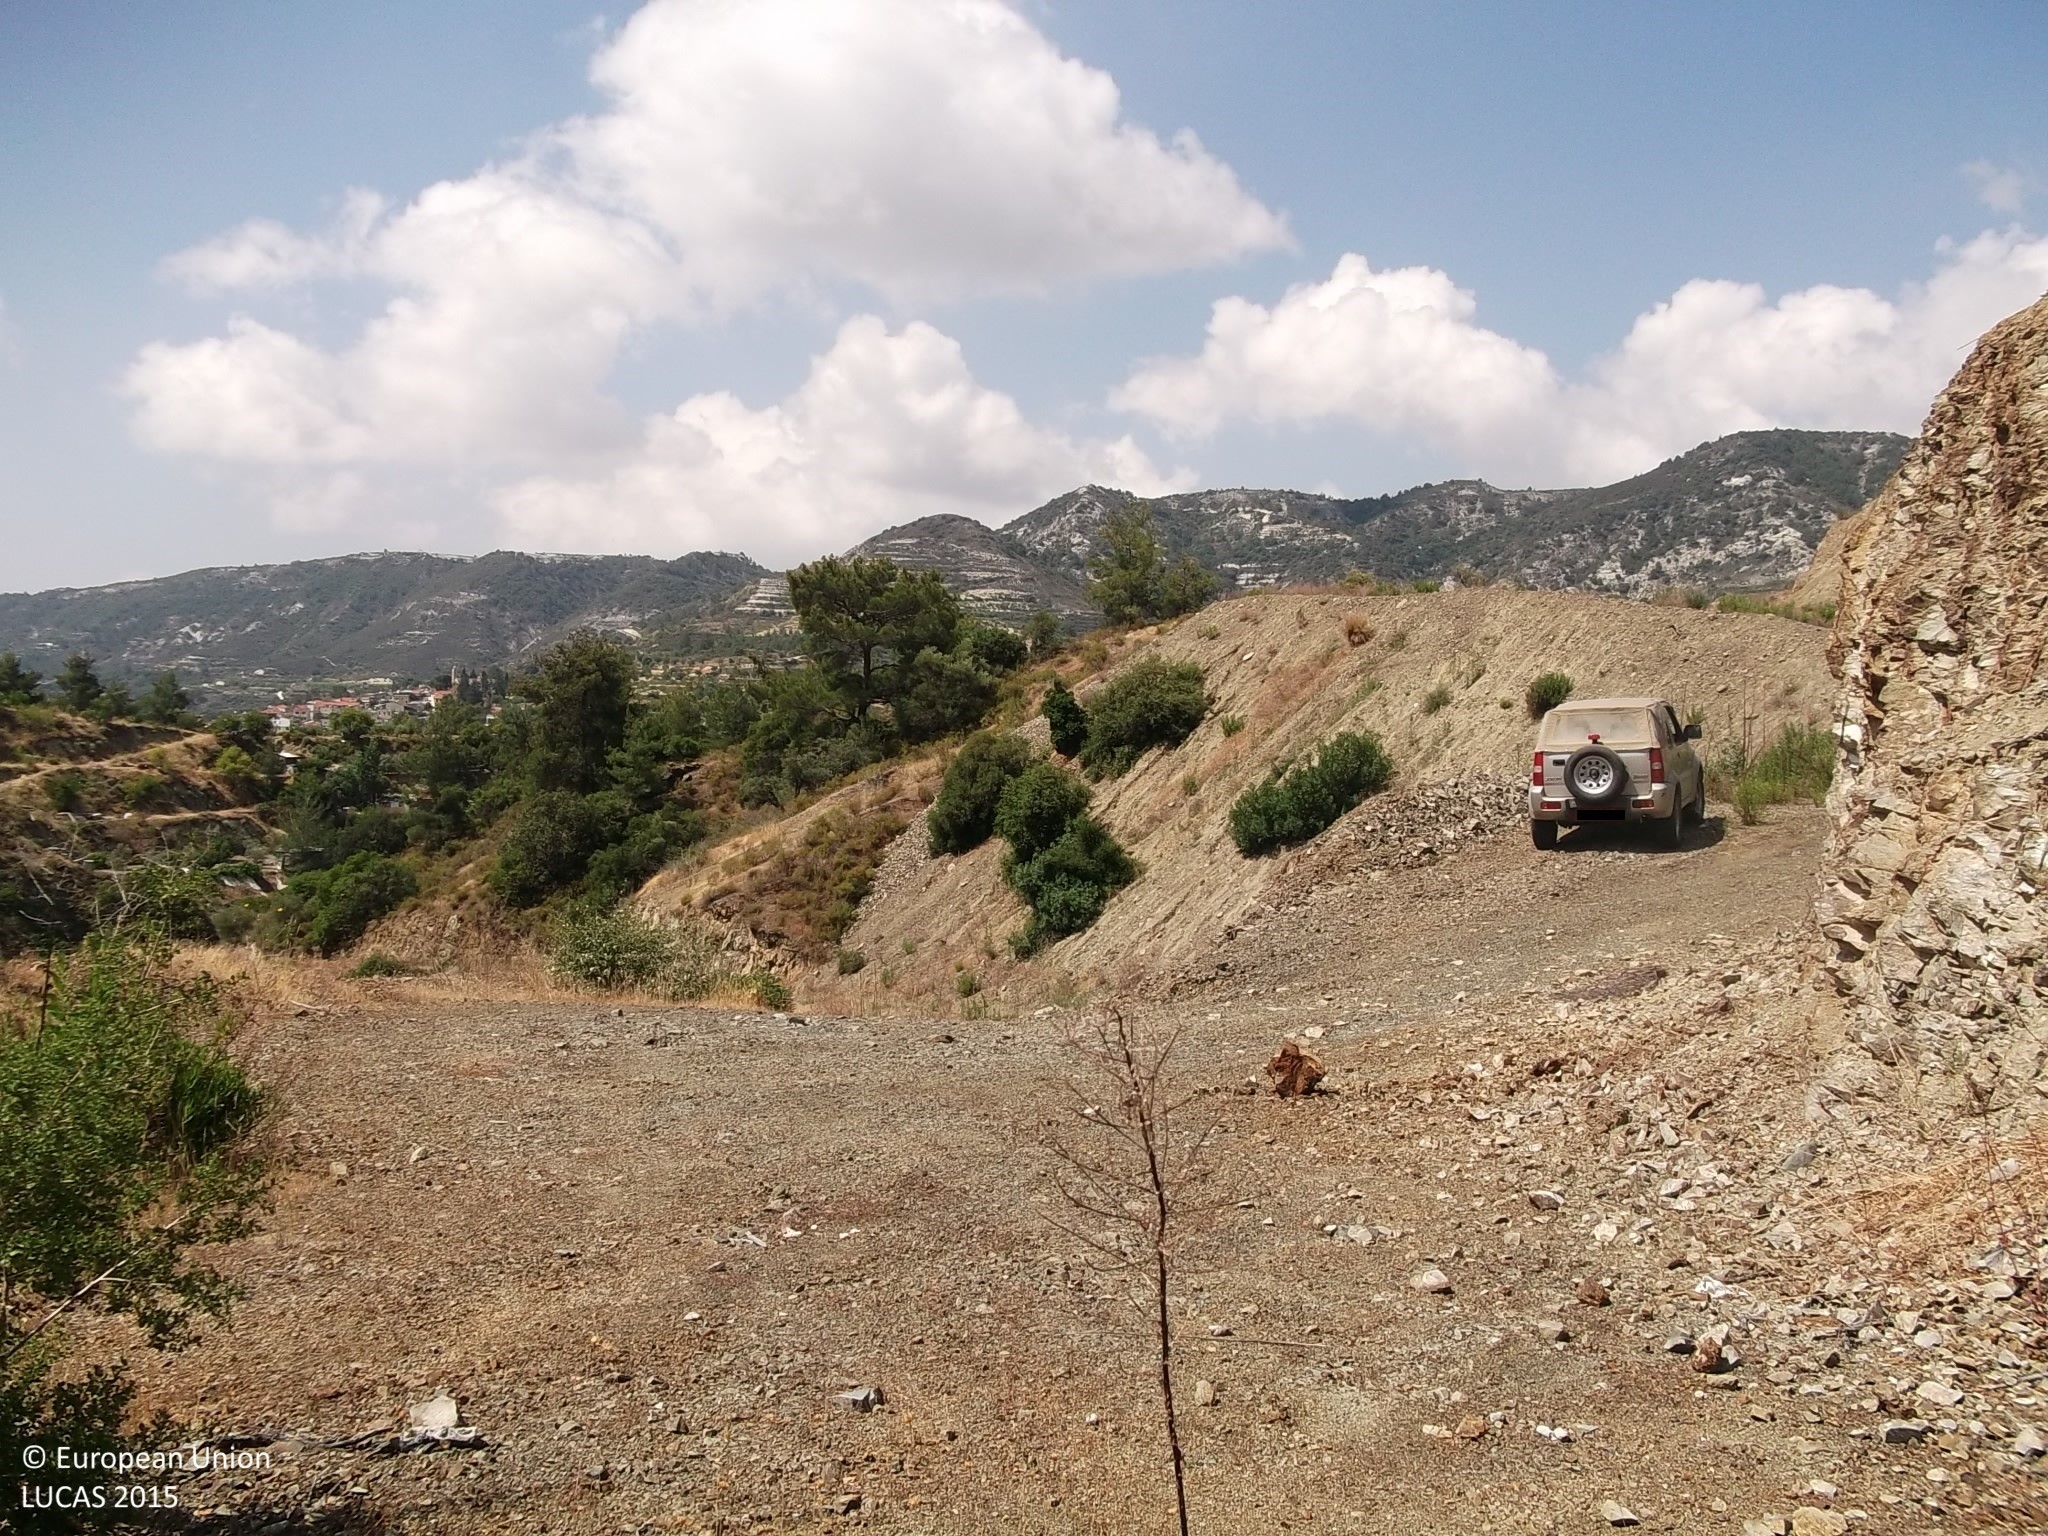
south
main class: Woodland
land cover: Pine dominated coniferous woodland
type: coniferous forest of the mediterranean region
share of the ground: > 75 %
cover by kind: coniferous forest trees 75 %, unconsolidated bare surface 15 %, shrubs 10 %
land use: Forestry
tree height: > 5 m
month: June
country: CY
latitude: 34.8624
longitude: 32.9523
